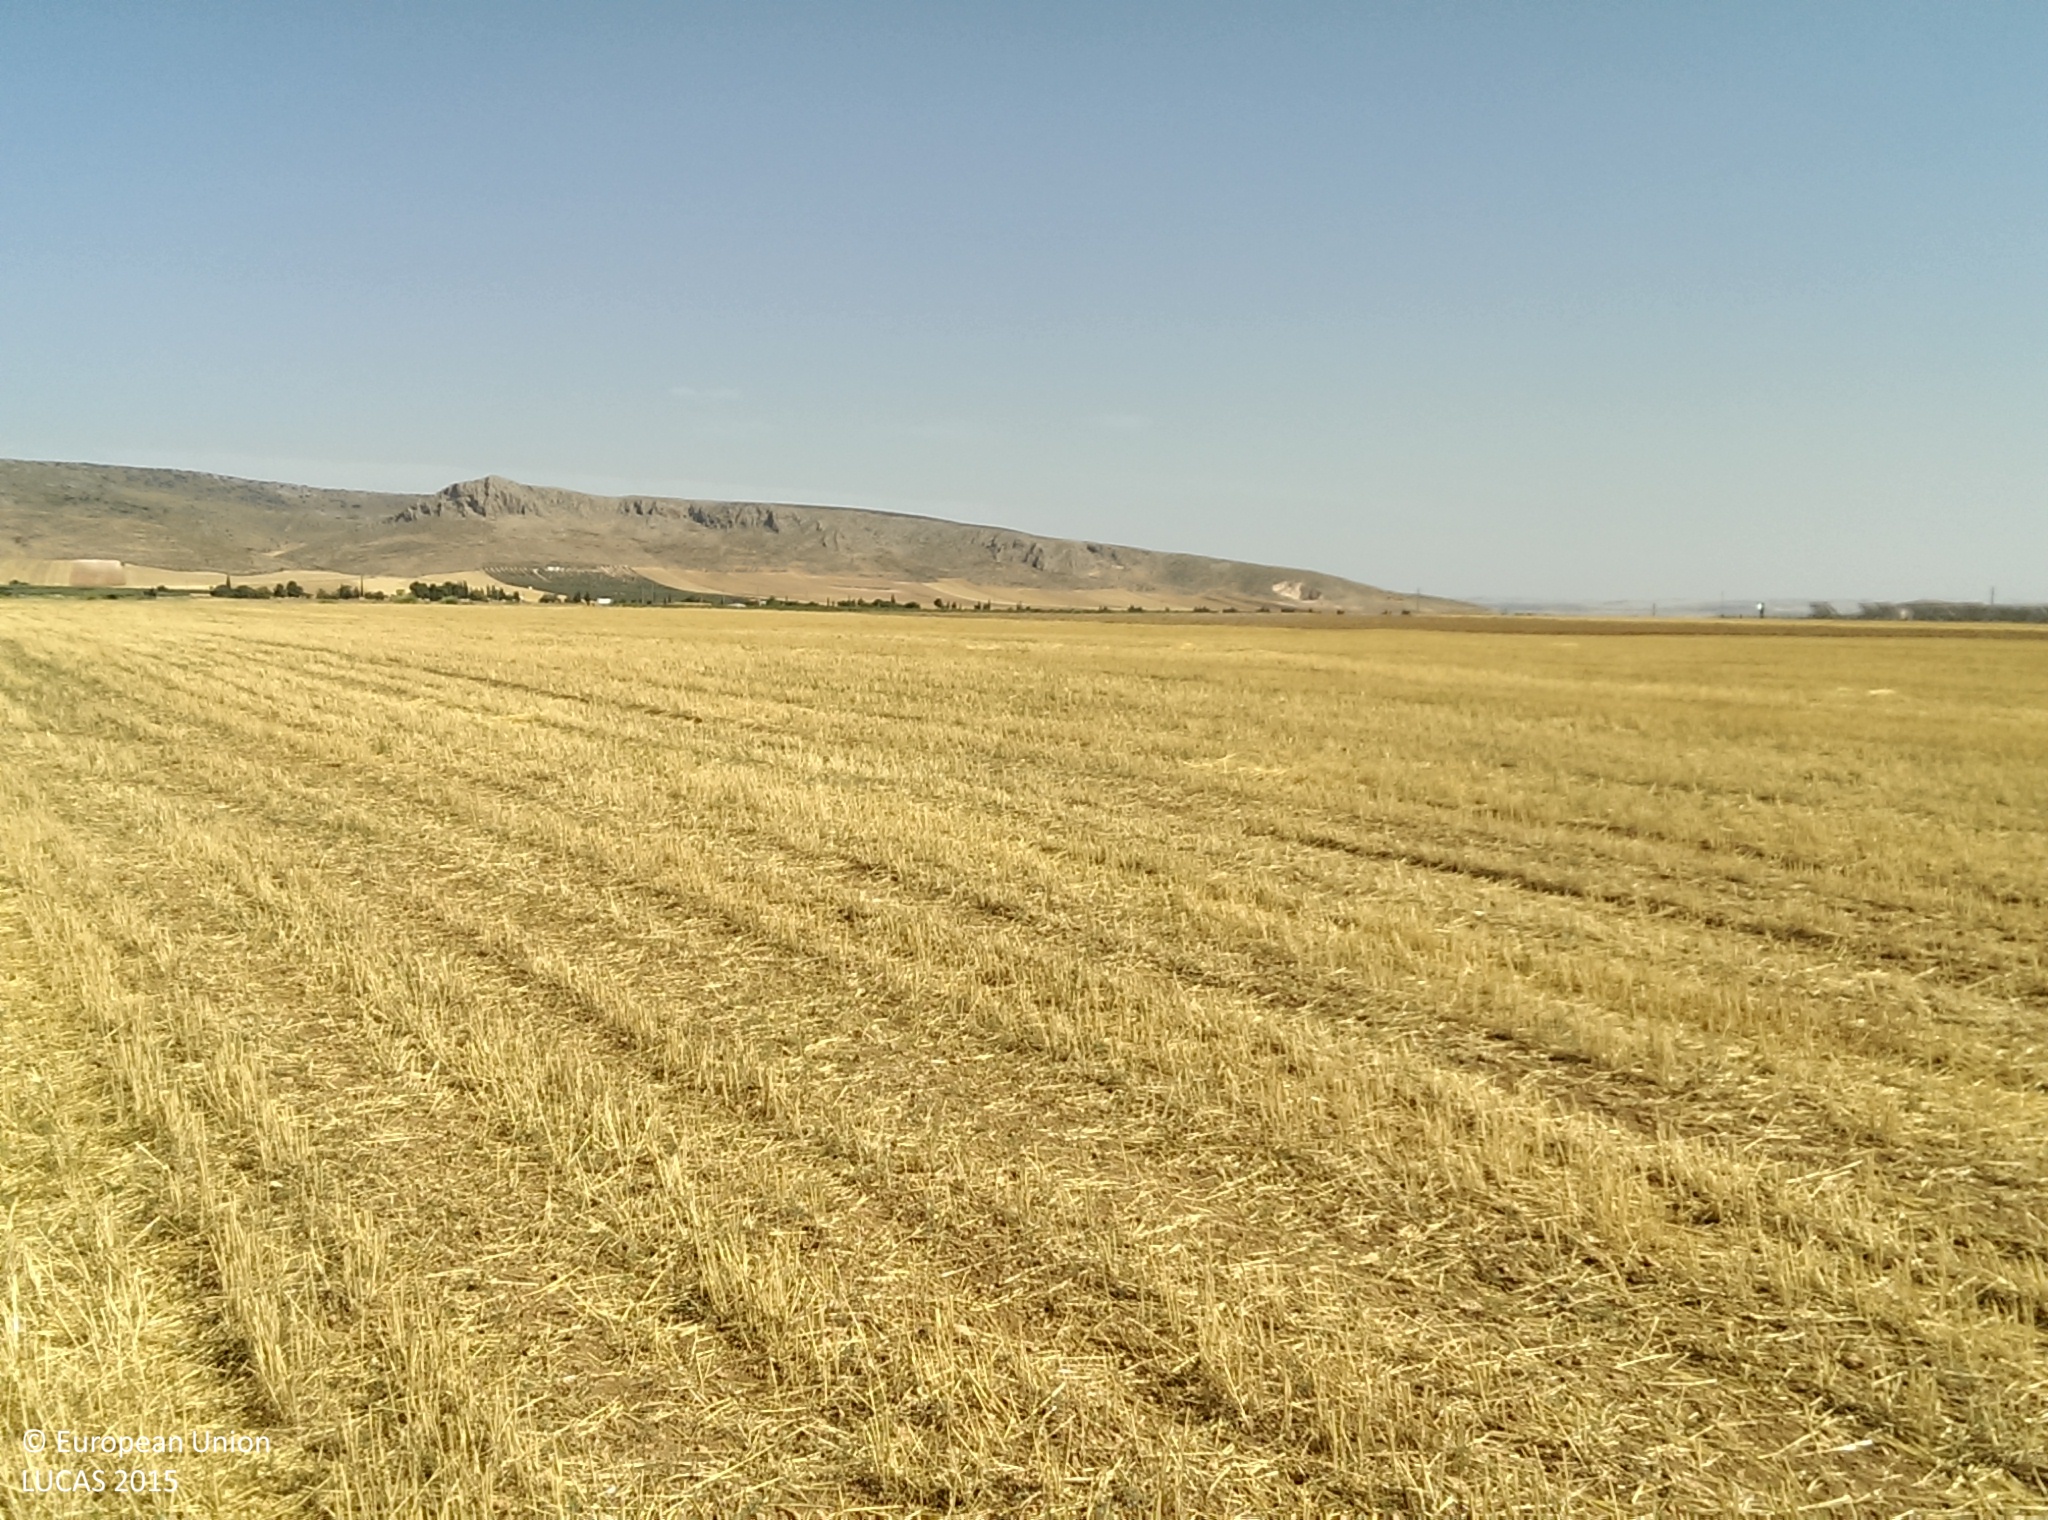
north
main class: Cropland
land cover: Barley
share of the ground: < 10 %
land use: Agriculture (excluding fallow land and kitchen gardens)
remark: Harvested field
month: July
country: ES
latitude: 37.3446
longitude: -3.2751
